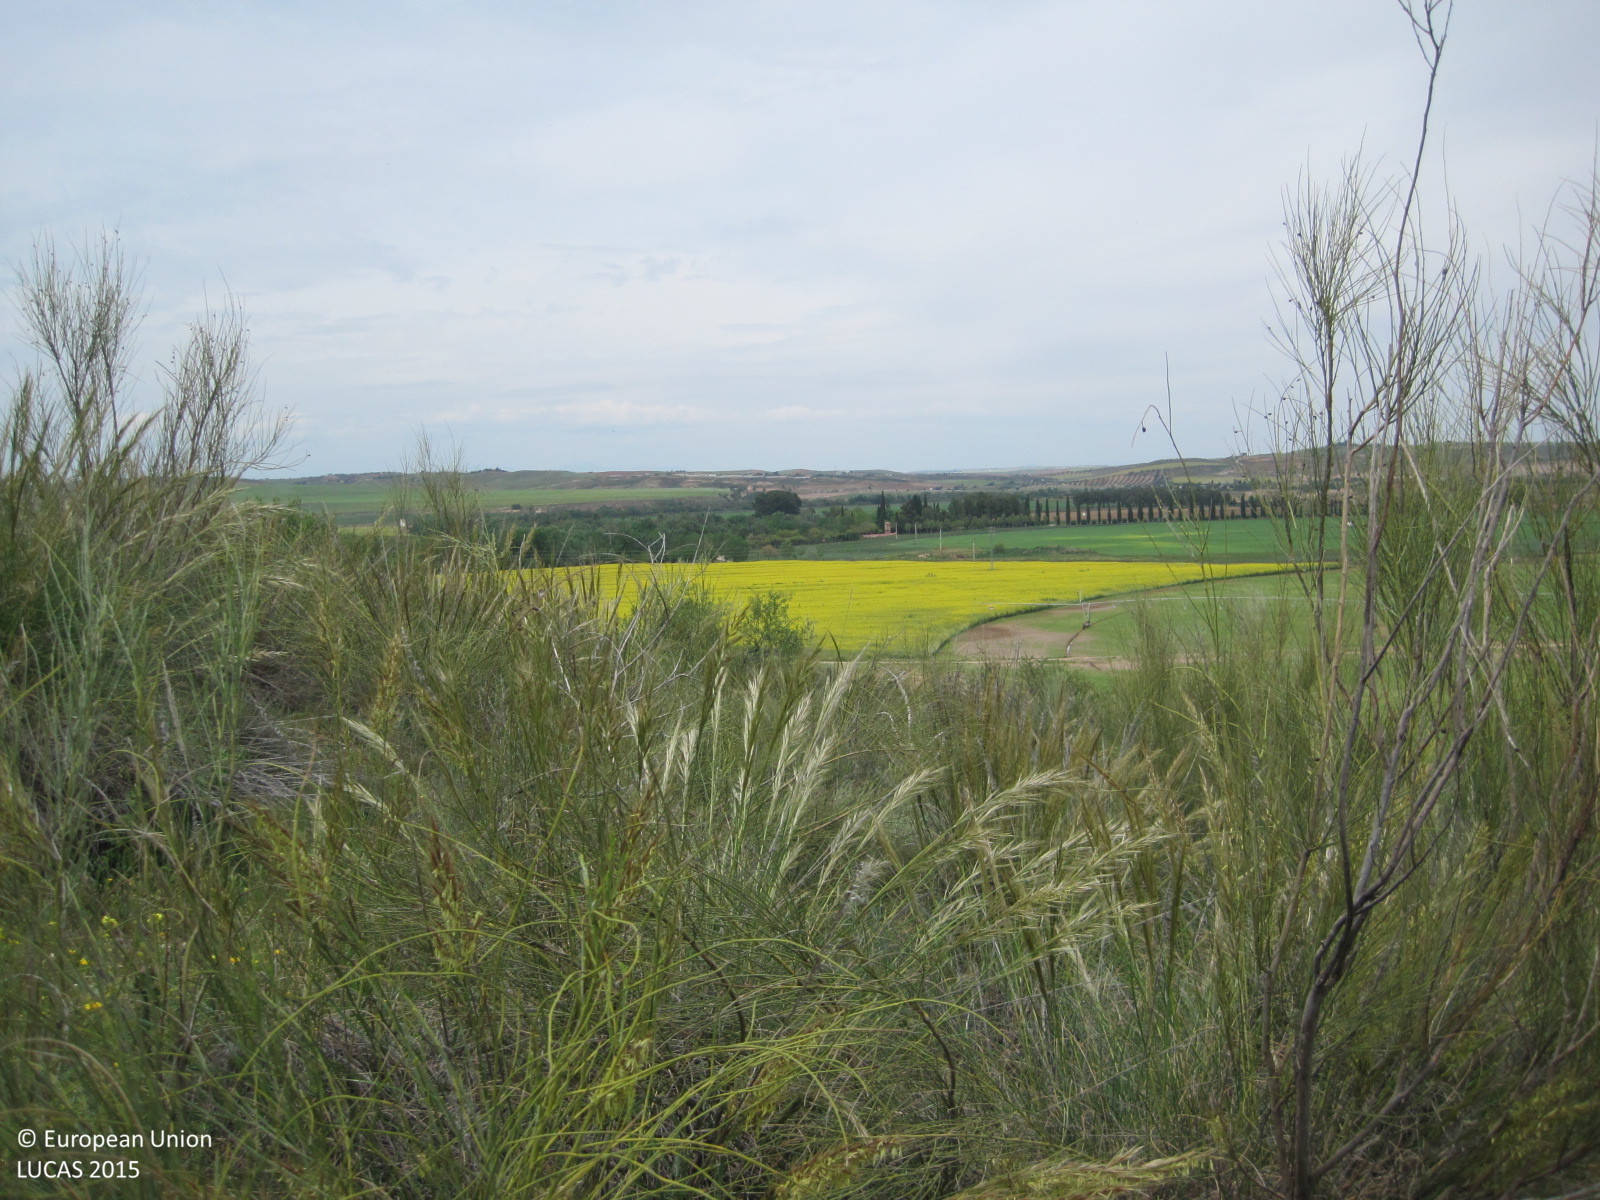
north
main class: Shrubland
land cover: Shrubland without tree cover
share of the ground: > 75 %
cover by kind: shrubs 100 %
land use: Semi-natural and natural areas not in use
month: April
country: ES
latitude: 39.8501
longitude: -4.2141
